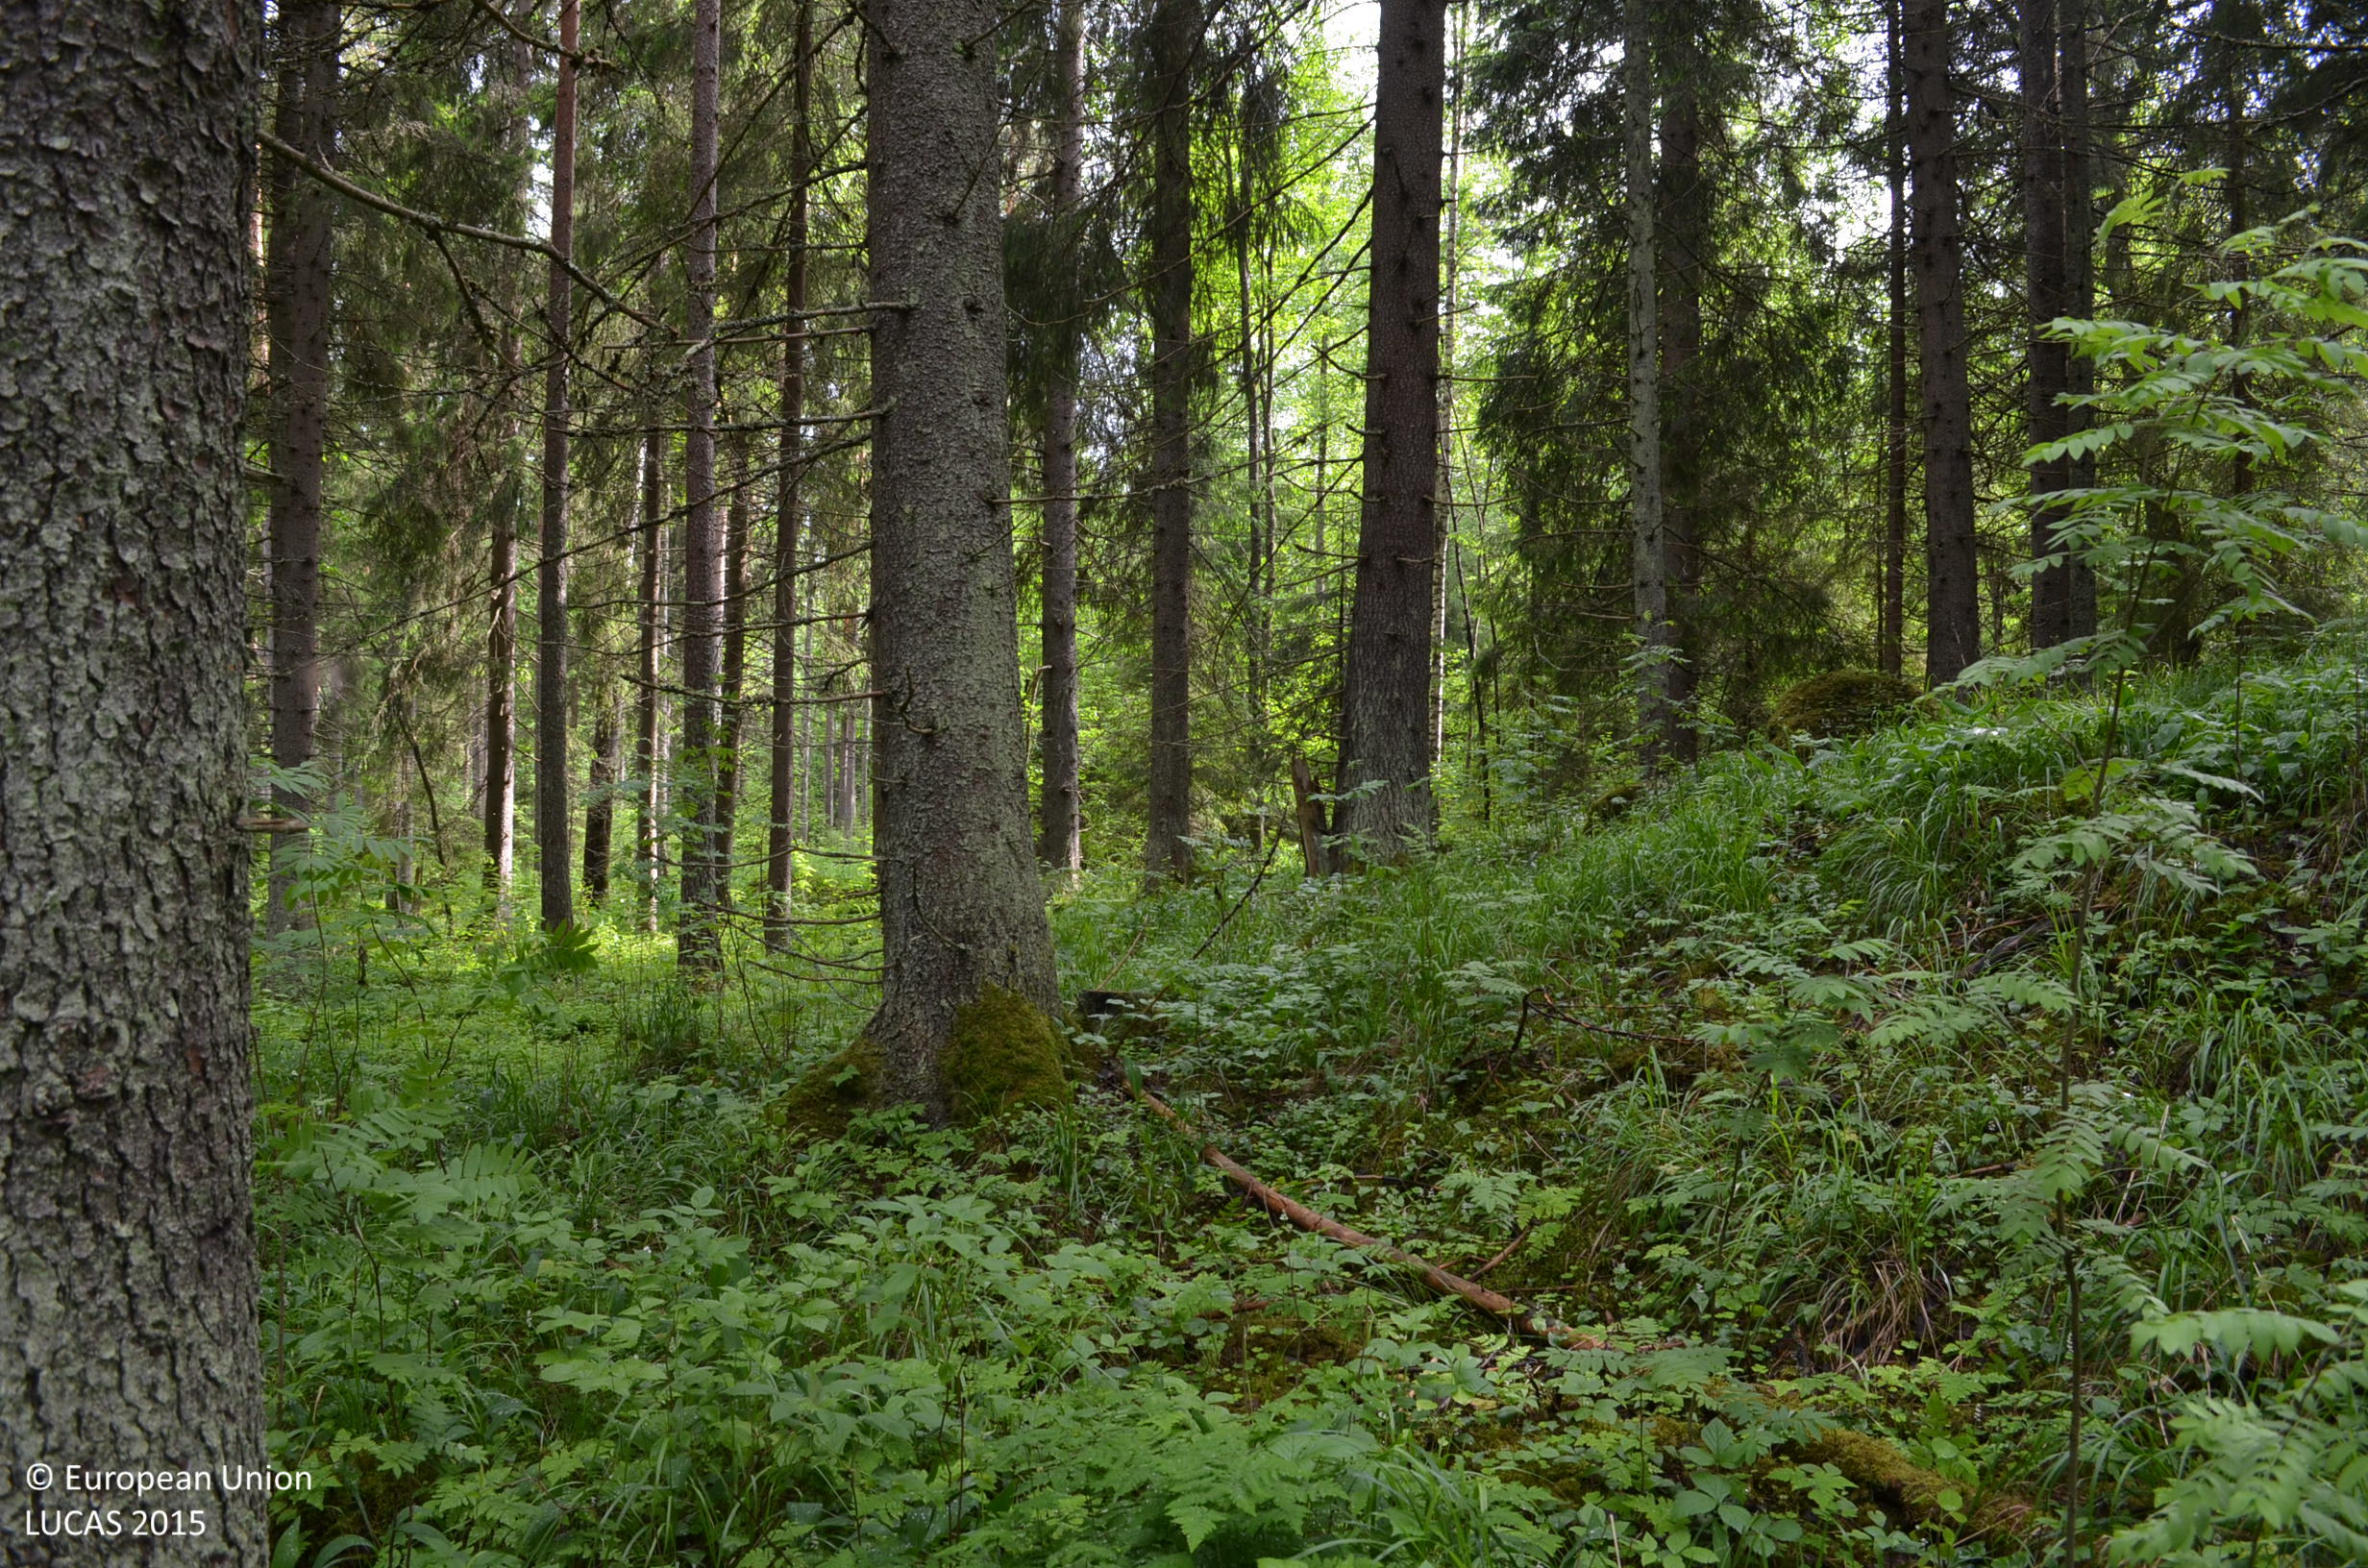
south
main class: Woodland
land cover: Spruce dominated coniferous woodland
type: boreal forest
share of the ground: > 75 %
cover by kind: coniferous forest trees 60 %, broadleaved forest trees 15 %, shrubs 15 %, herbaceous plants 10 %
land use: Forestry
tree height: > 5 m
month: June
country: FI
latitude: 61.7364
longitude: 23.3836
